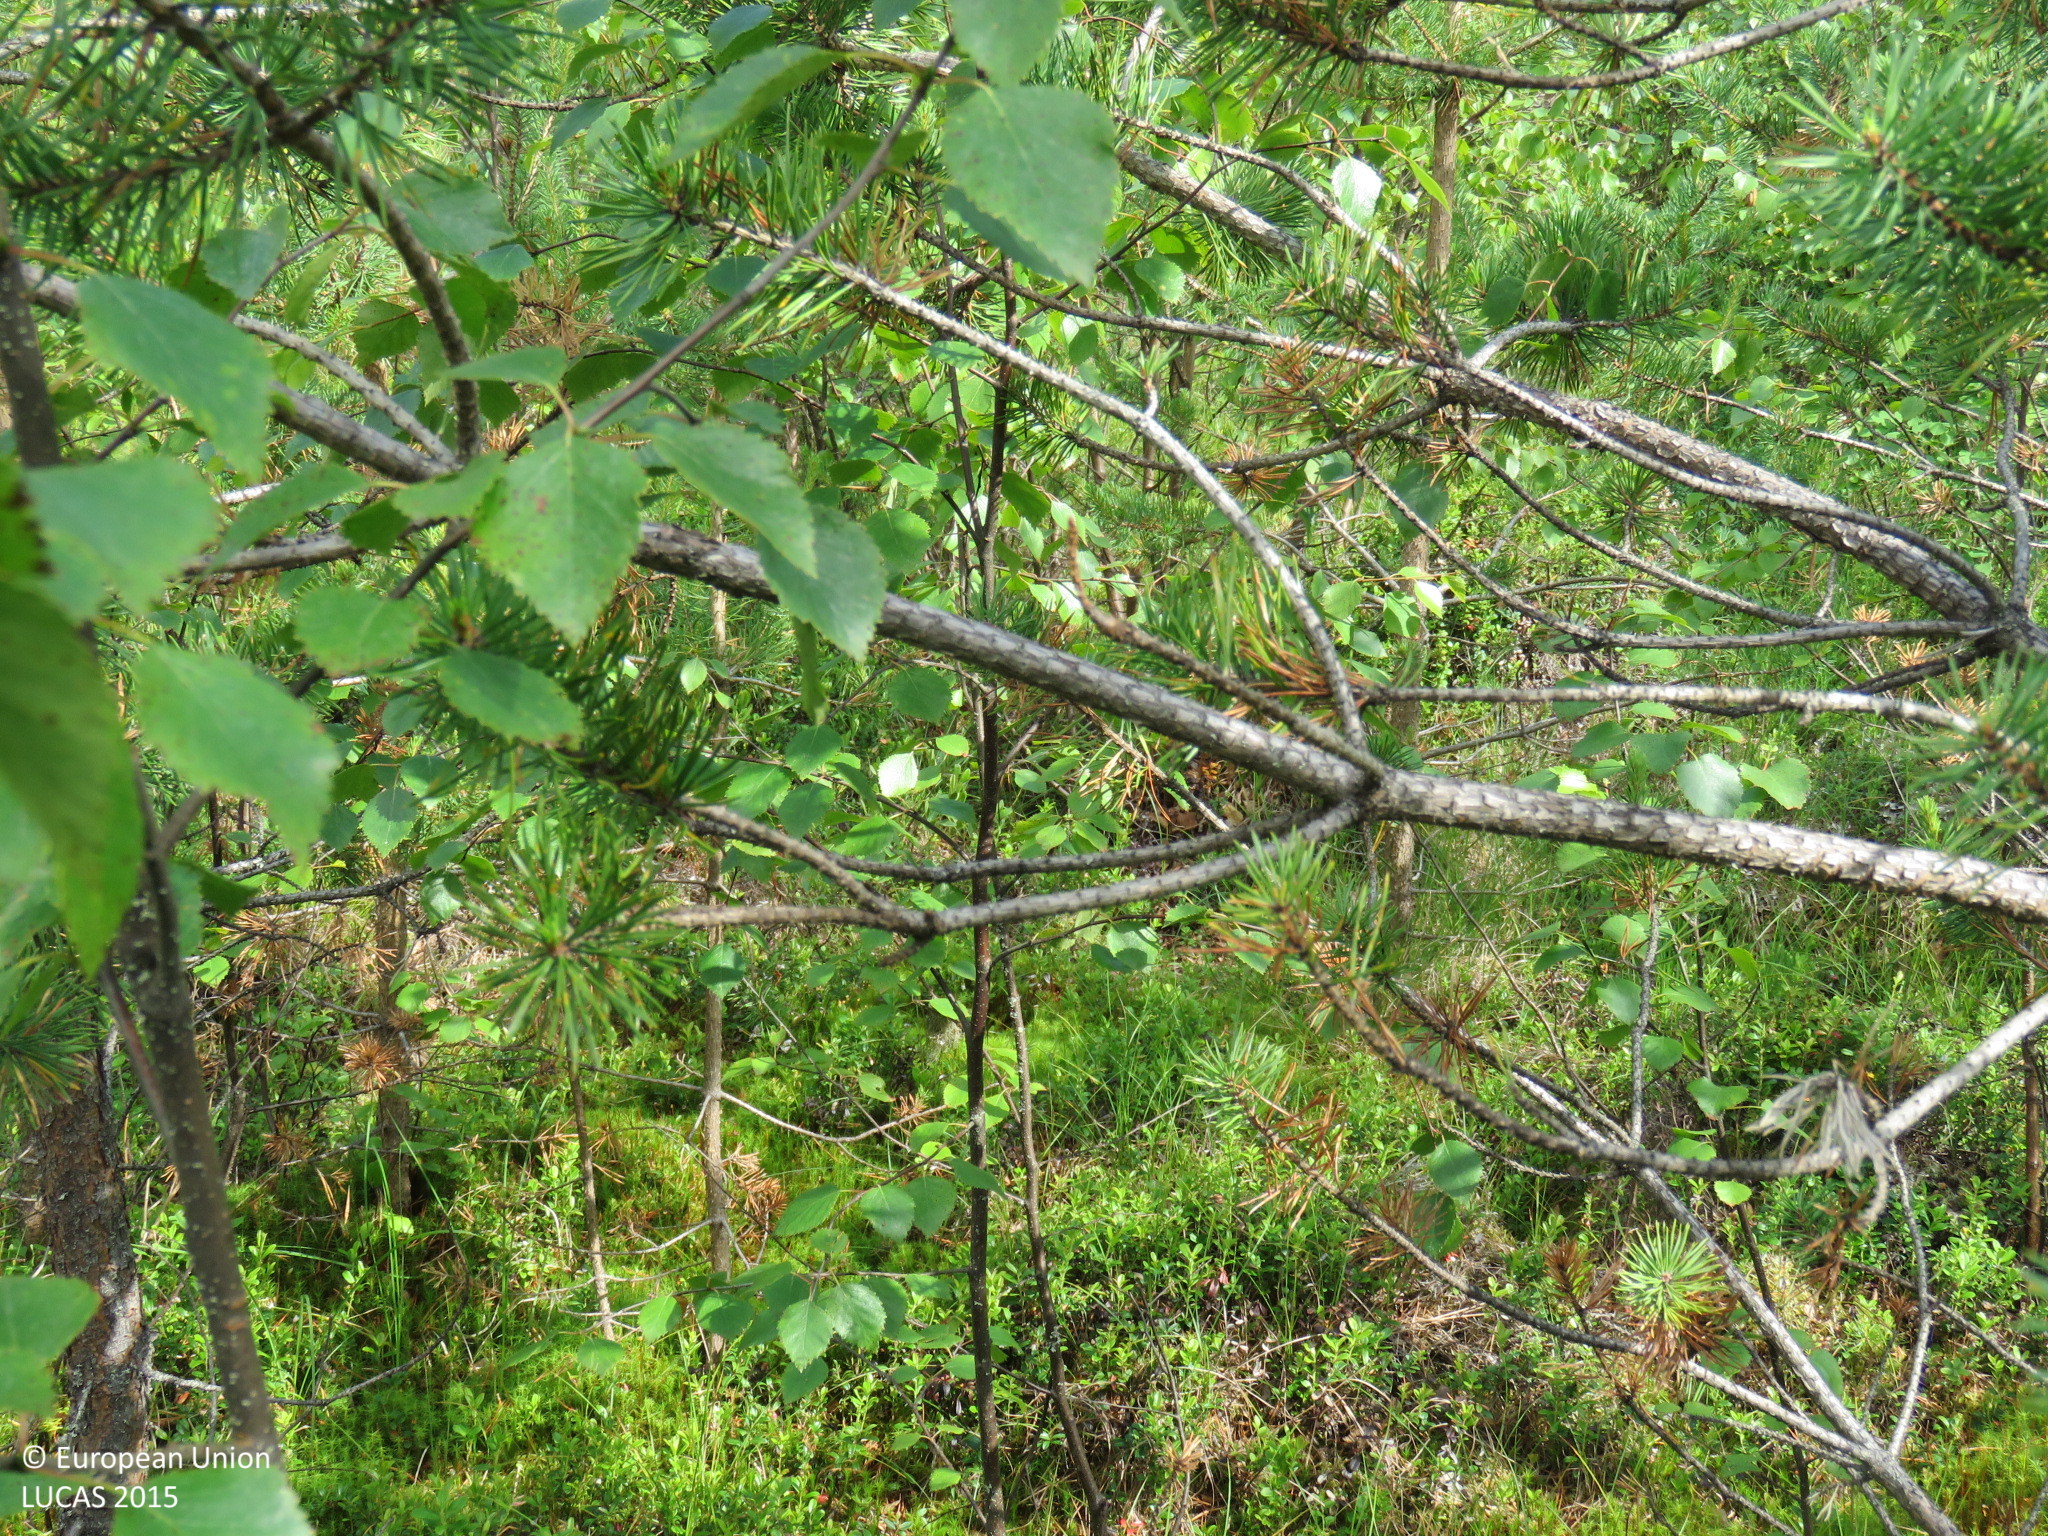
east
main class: Woodland
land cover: Pine dominated mixed woodland
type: boreal forest
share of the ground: > 75 %
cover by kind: broadleaved forest trees 50 %, coniferous forest trees 45 %, shrubs 5 %
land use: Forestry
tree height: < 5 m
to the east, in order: Pine dominated mixed woodland; Broadleaved woodland; Ditches and canals; Pine dominated mixed woodland; Ditches and canals; Pine dominated mixed woodland; Ditches and canals; Pine dominated mixed woodland; Ditches and canals; Pine dominated mixed woodland; Ditches and canals; Pine dominated mixed woodland; Pine dominated coniferous woodland
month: July
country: FI
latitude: 64.6384
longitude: 26.4964
